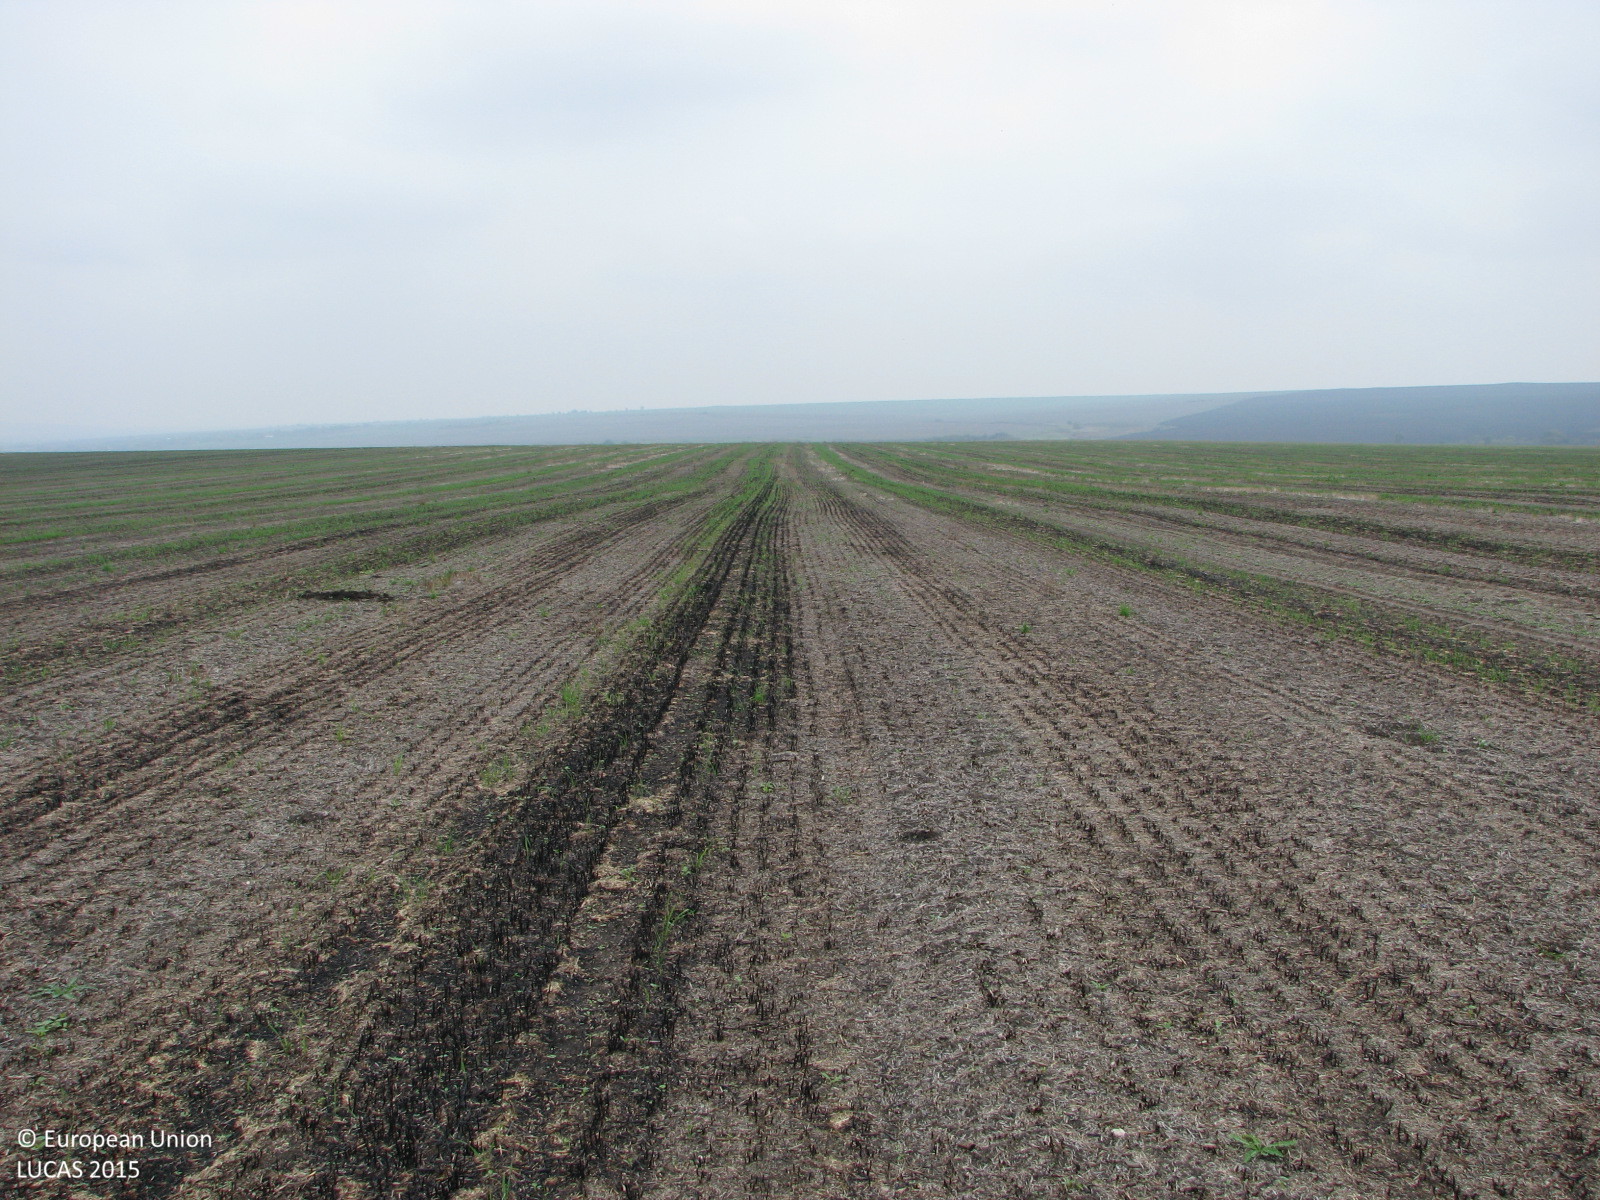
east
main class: Cropland
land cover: Common wheat
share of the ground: 10 - 25 %
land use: Agriculture (excluding fallow land and kitchen gardens)
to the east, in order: Common wheat
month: October
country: BG
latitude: 42.3557
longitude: 26.6166
